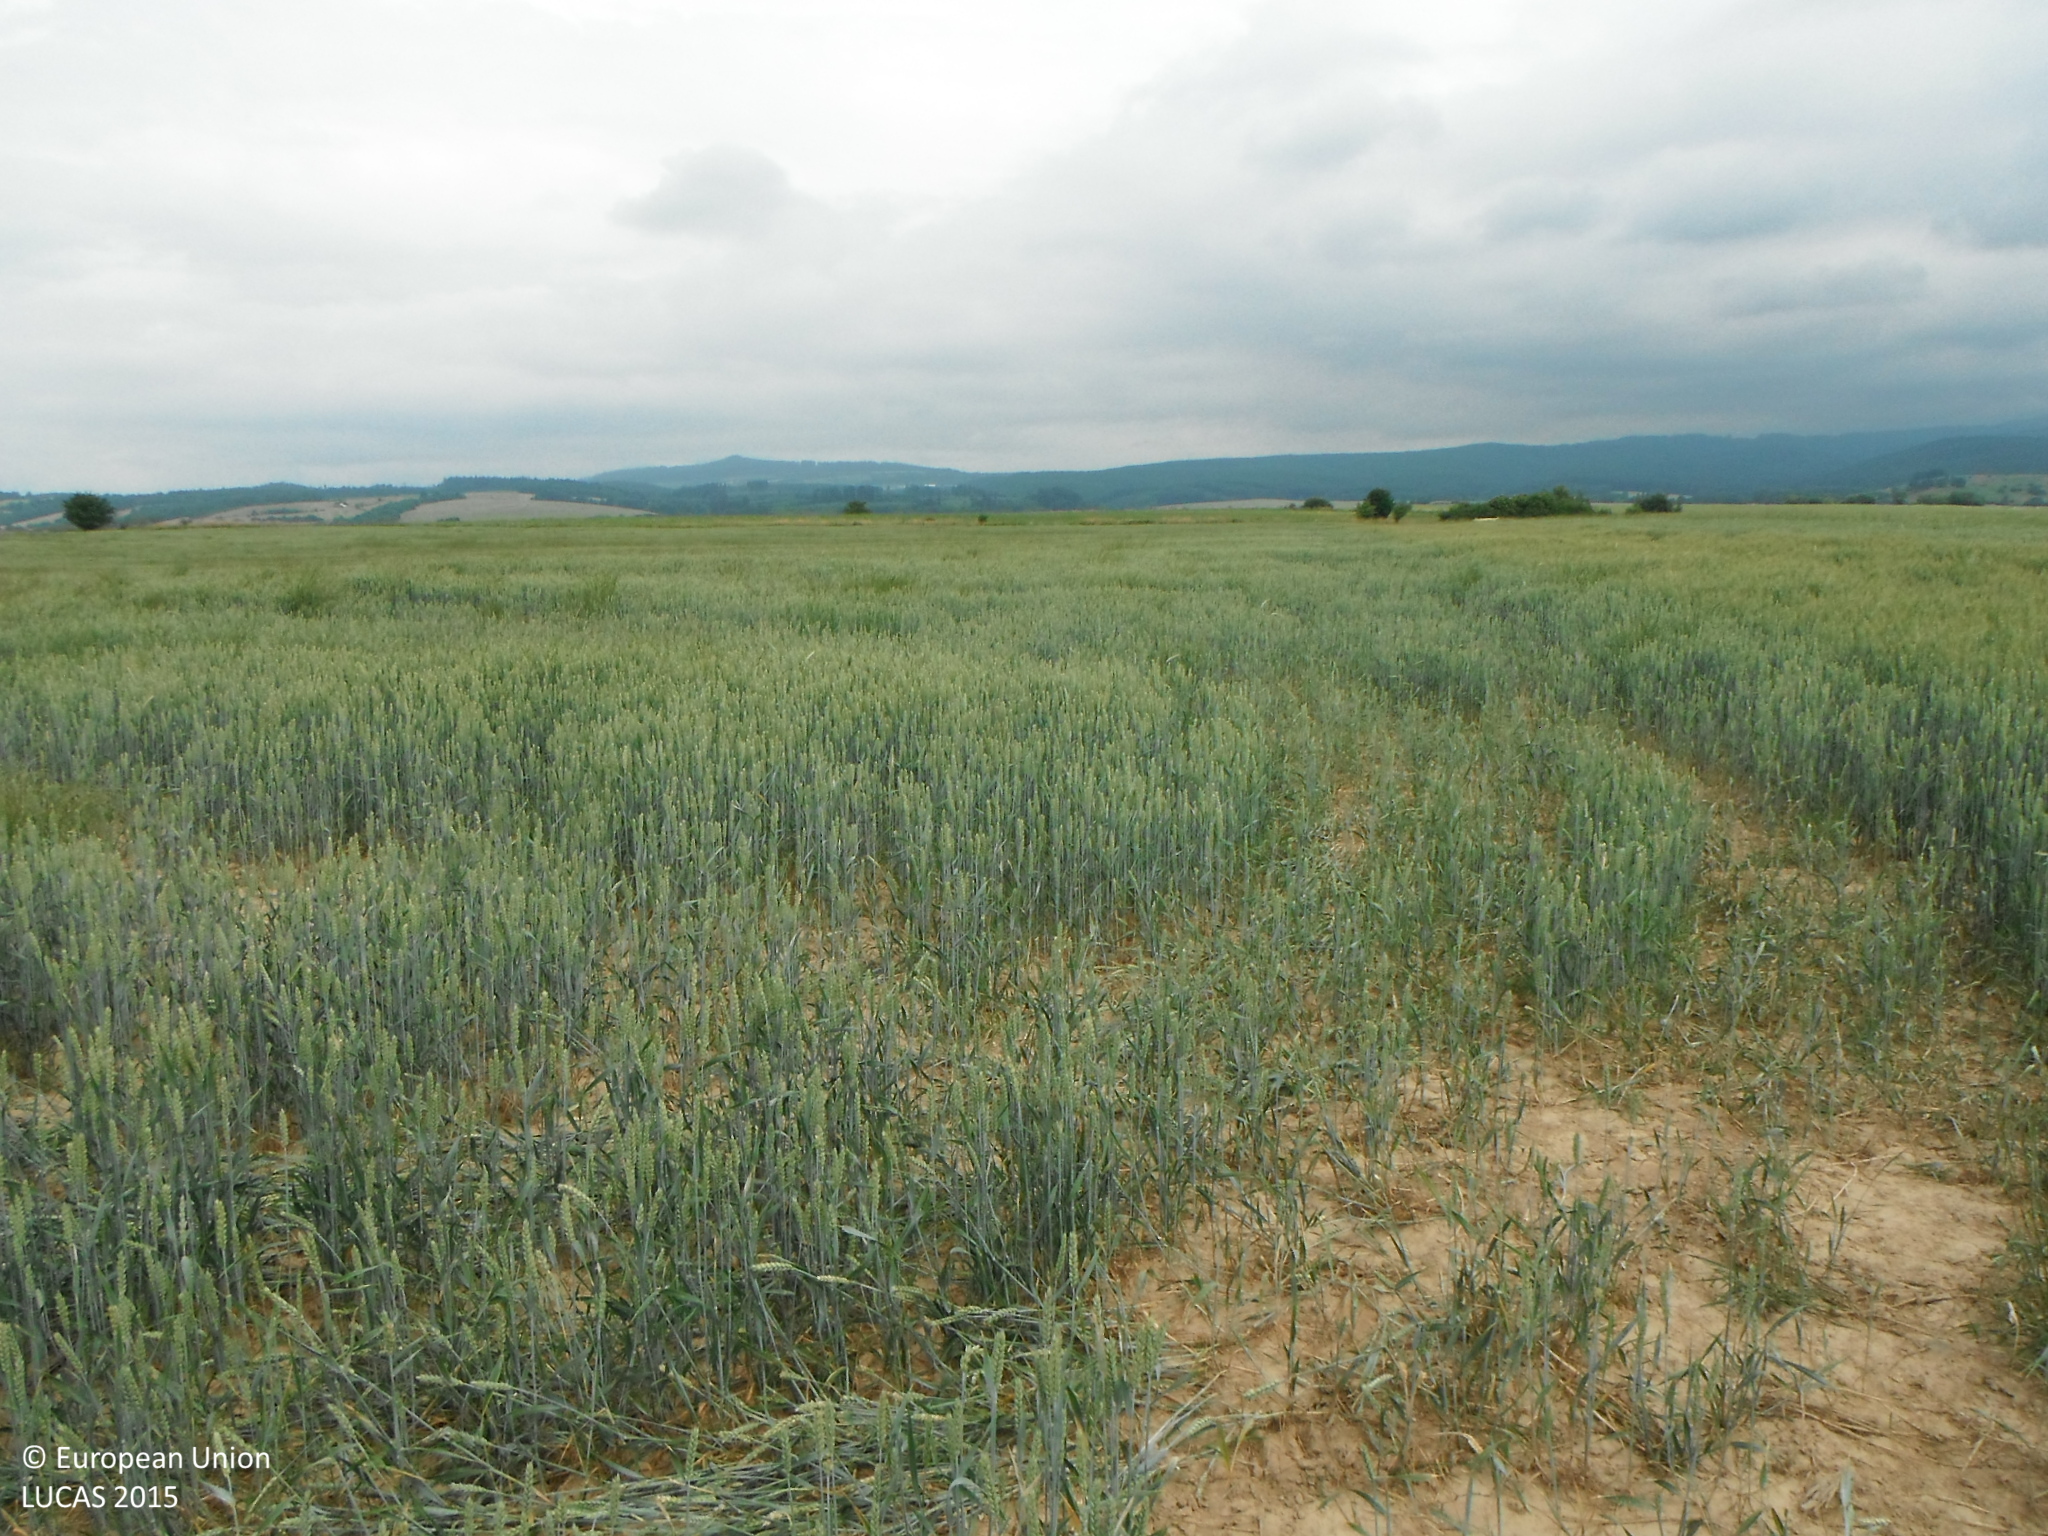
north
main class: Cropland
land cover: Common wheat
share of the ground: > 75 %
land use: Agriculture (excluding fallow land and kitchen gardens)
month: June
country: SK
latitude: 48.5894
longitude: 19.3103
